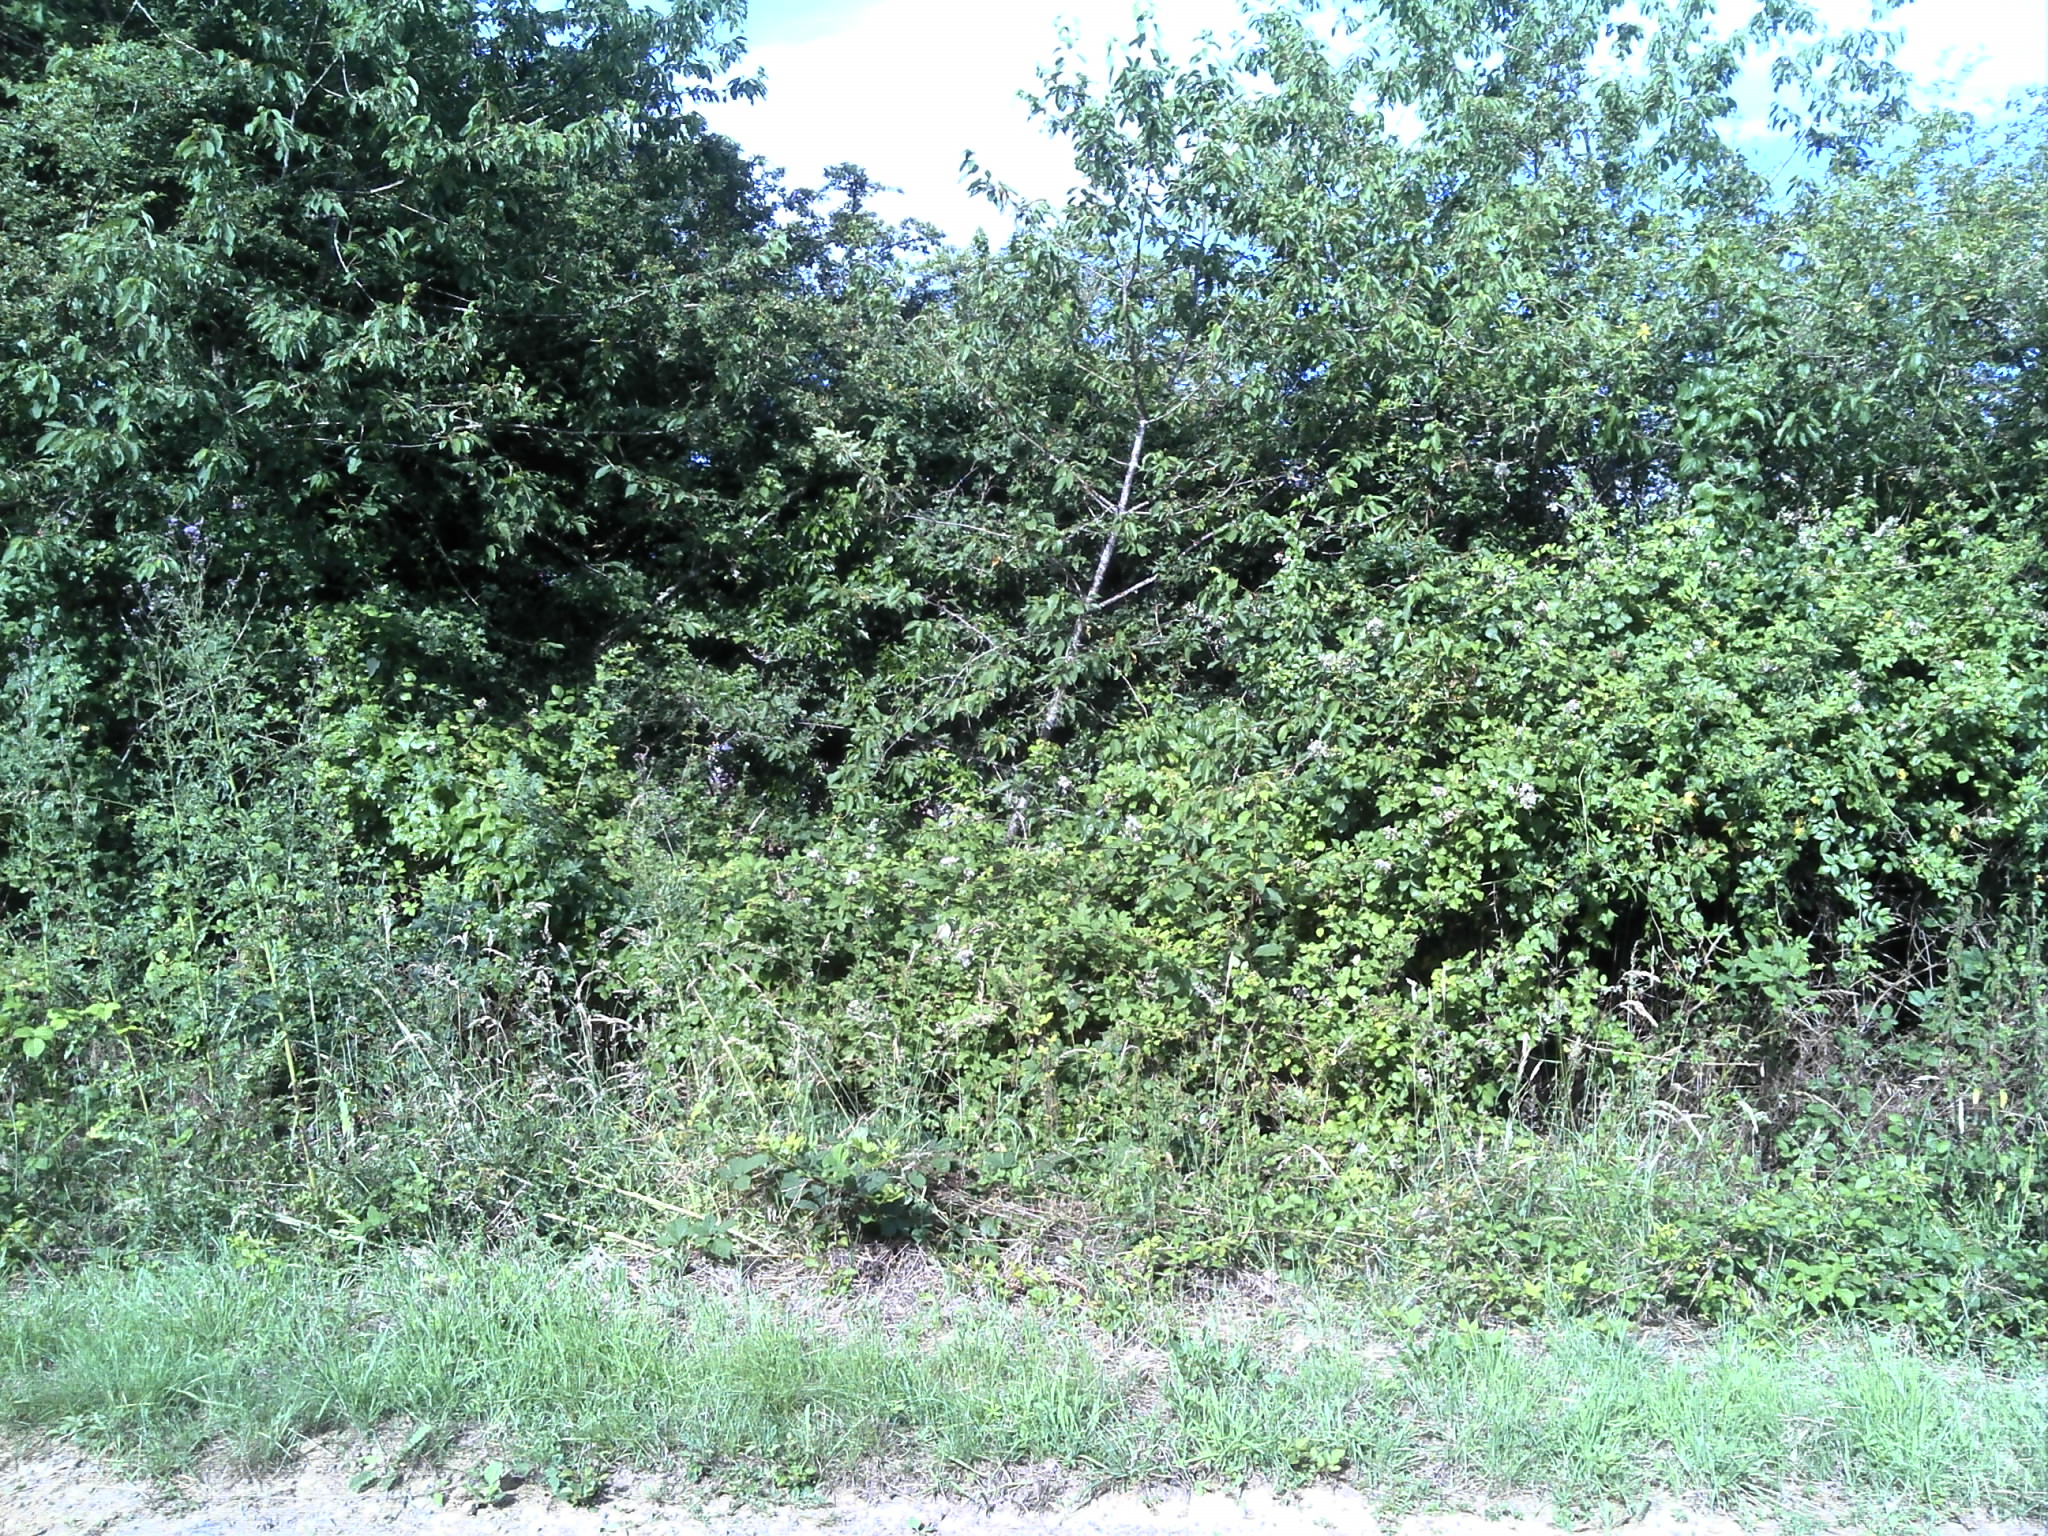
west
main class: Woodland
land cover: Broadleaved woodland
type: mesophytic deciduous forest
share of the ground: > 75 %
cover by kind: broadleaved forest trees 50 %, shrubs 50 %
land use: Semi-natural and natural areas not in use
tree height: < 5 m
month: June
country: FR
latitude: 46.5575
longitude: 1.5241
